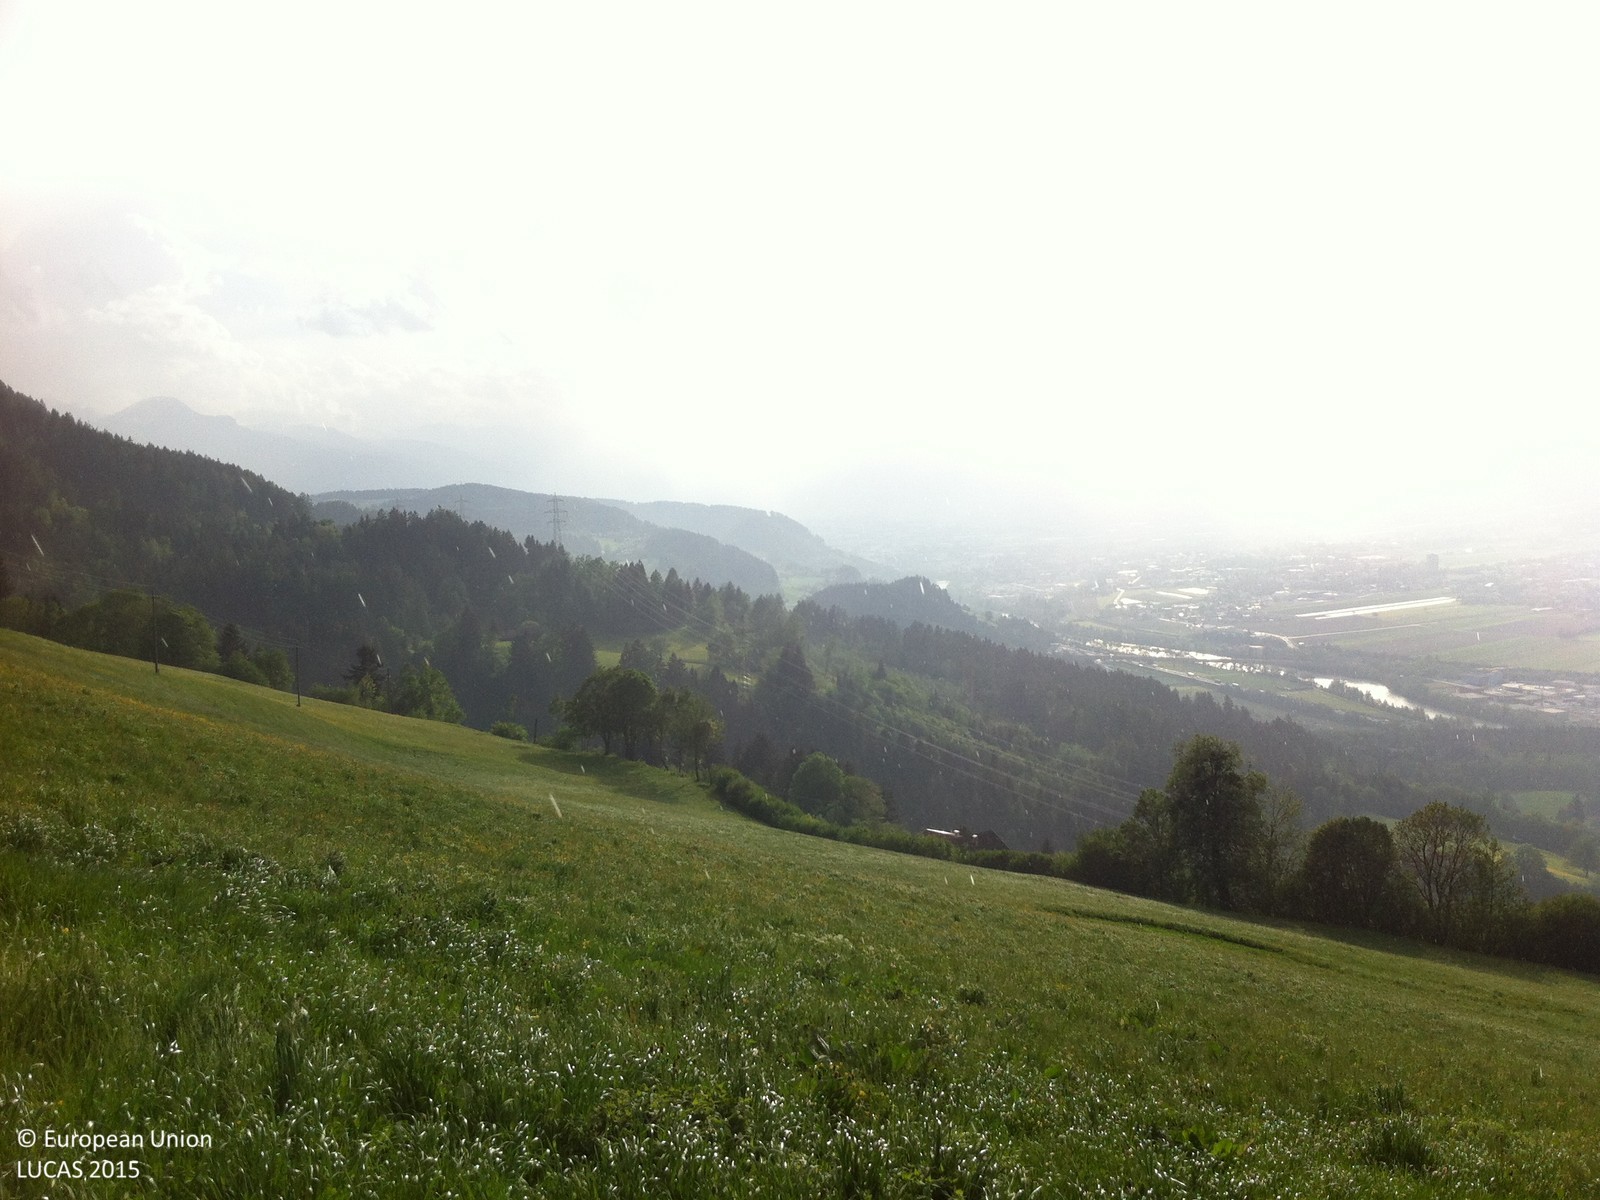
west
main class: Grassland
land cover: Grassland without tree/shrub cover
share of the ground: > 75 %
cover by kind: herbaceous plants 100 %
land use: Agriculture (excluding fallow land and kitchen gardens)
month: May
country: AT
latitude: 47.2762
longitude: 11.5717
